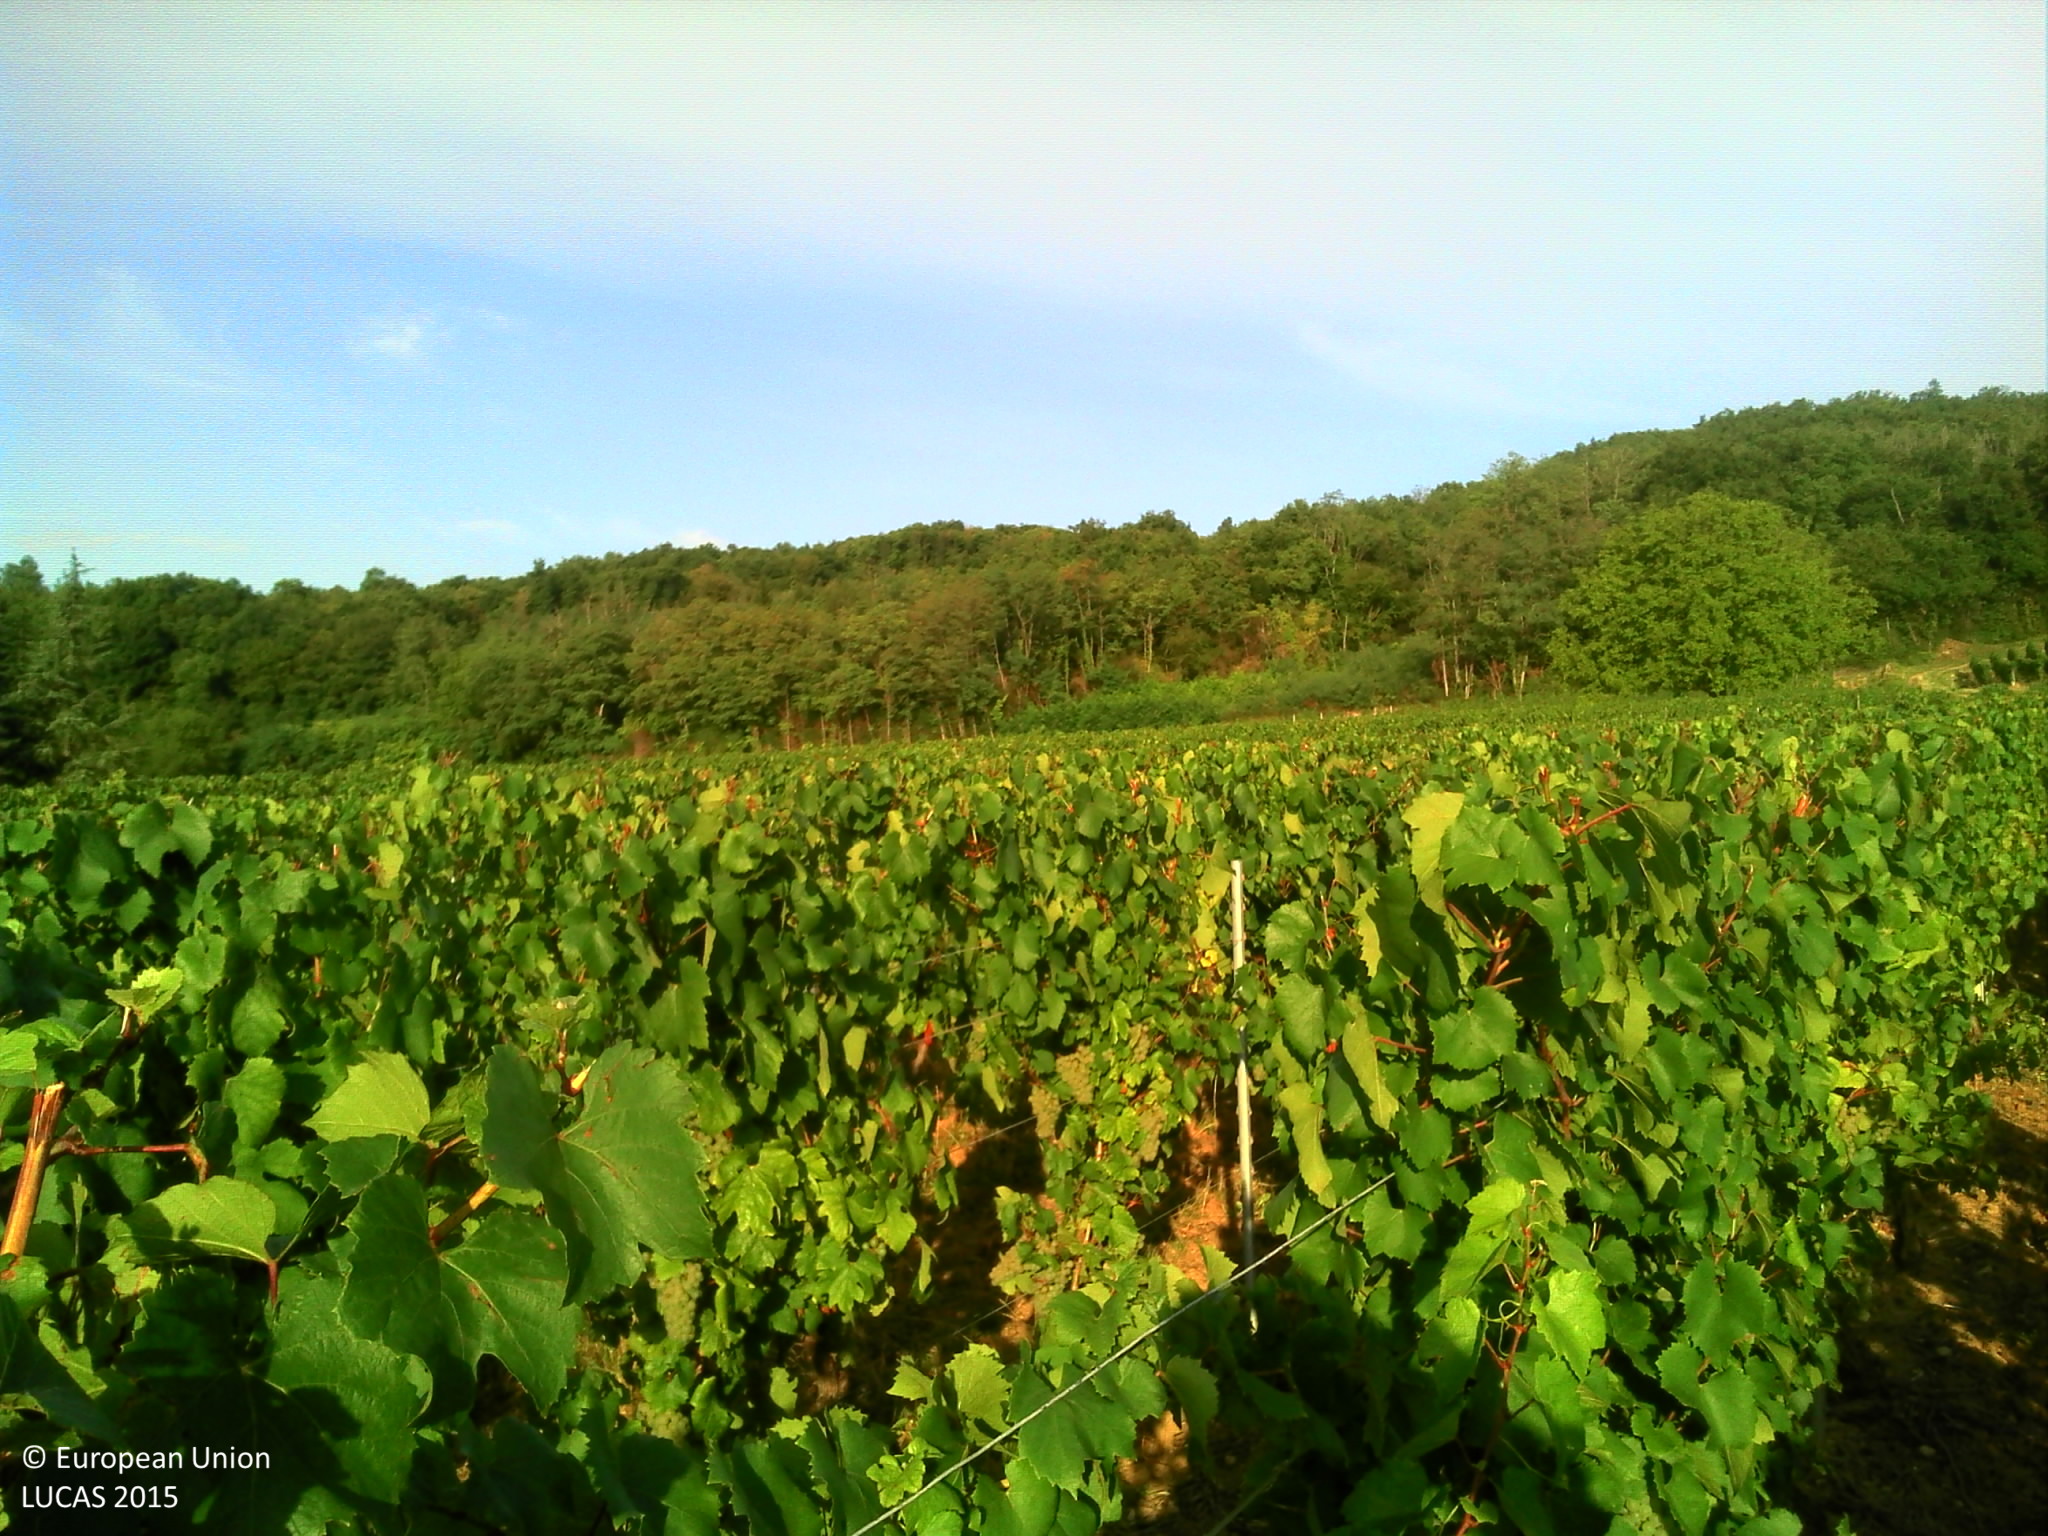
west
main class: Cropland
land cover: Vineyards
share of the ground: 50 - 75 %
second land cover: Other bare soil
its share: > 75 %
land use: Agriculture (excluding fallow land and kitchen gardens)
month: August
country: FR
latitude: 46.4430
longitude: 4.8344
